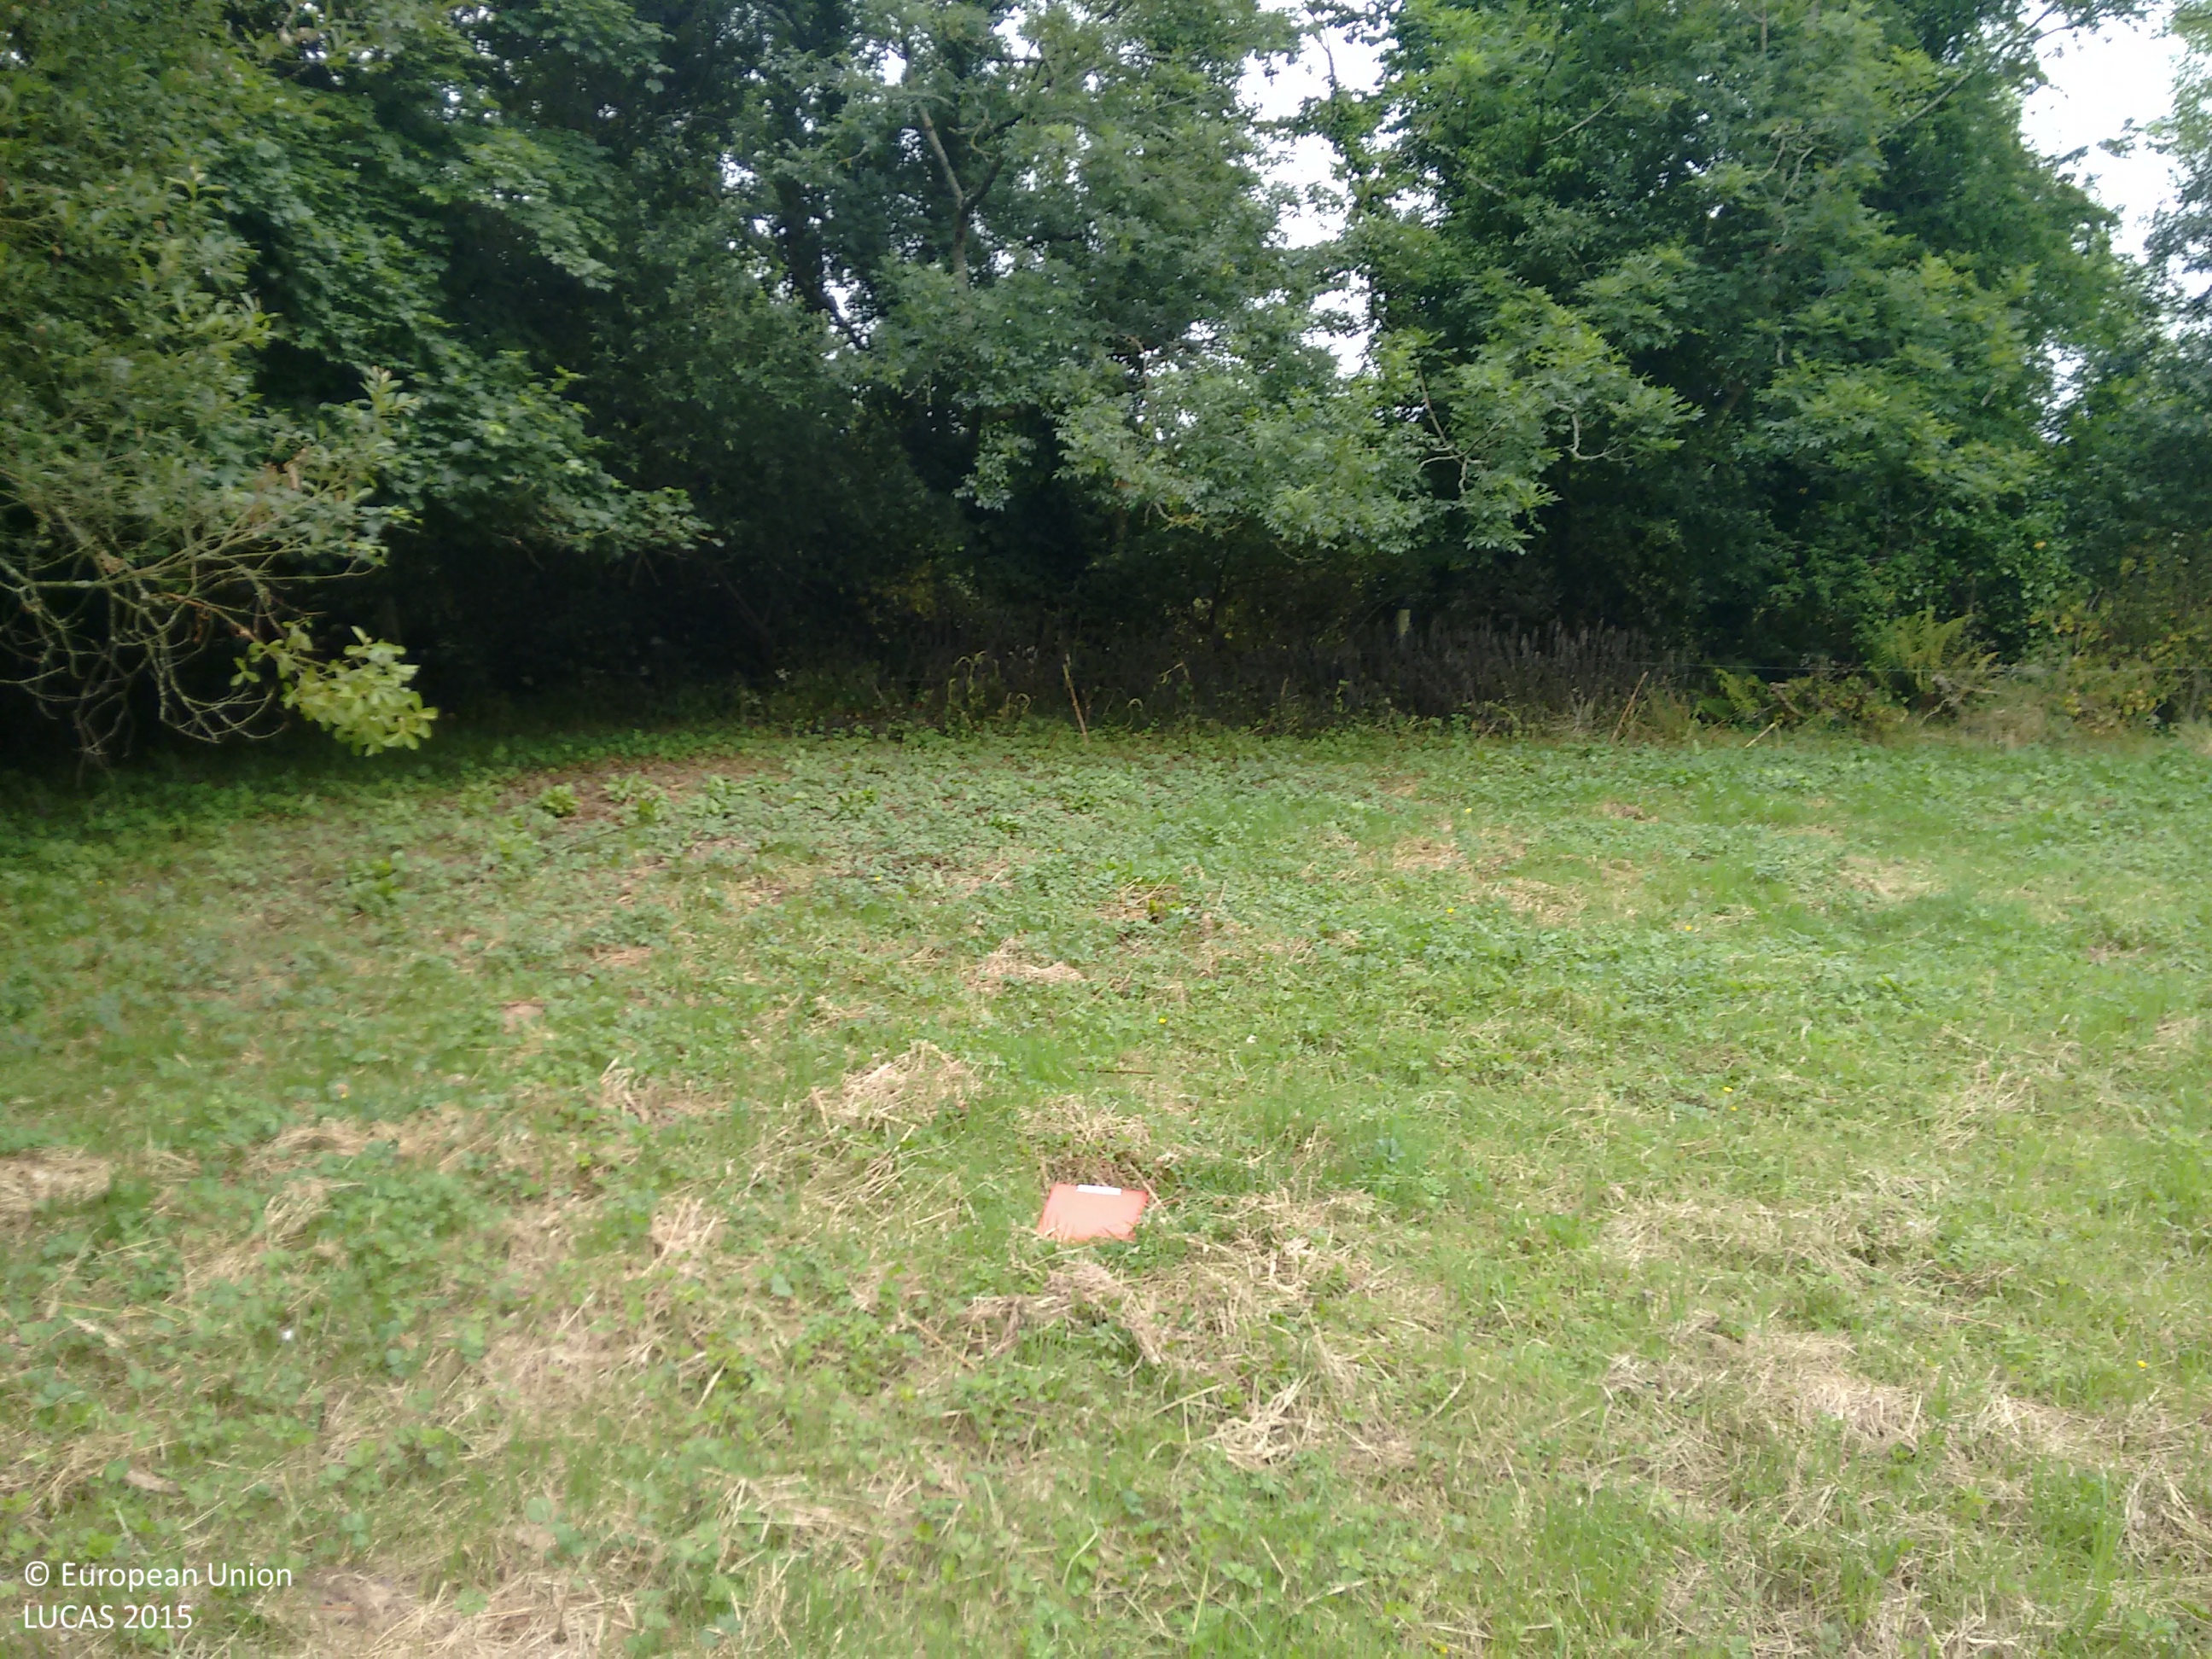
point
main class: Grassland
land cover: Grassland without tree/shrub cover
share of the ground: > 75 %
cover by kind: herbaceous plants 100 %
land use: Agriculture (excluding fallow land and kitchen gardens)
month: June
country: IE
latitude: 52.2474
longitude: -7.2133
